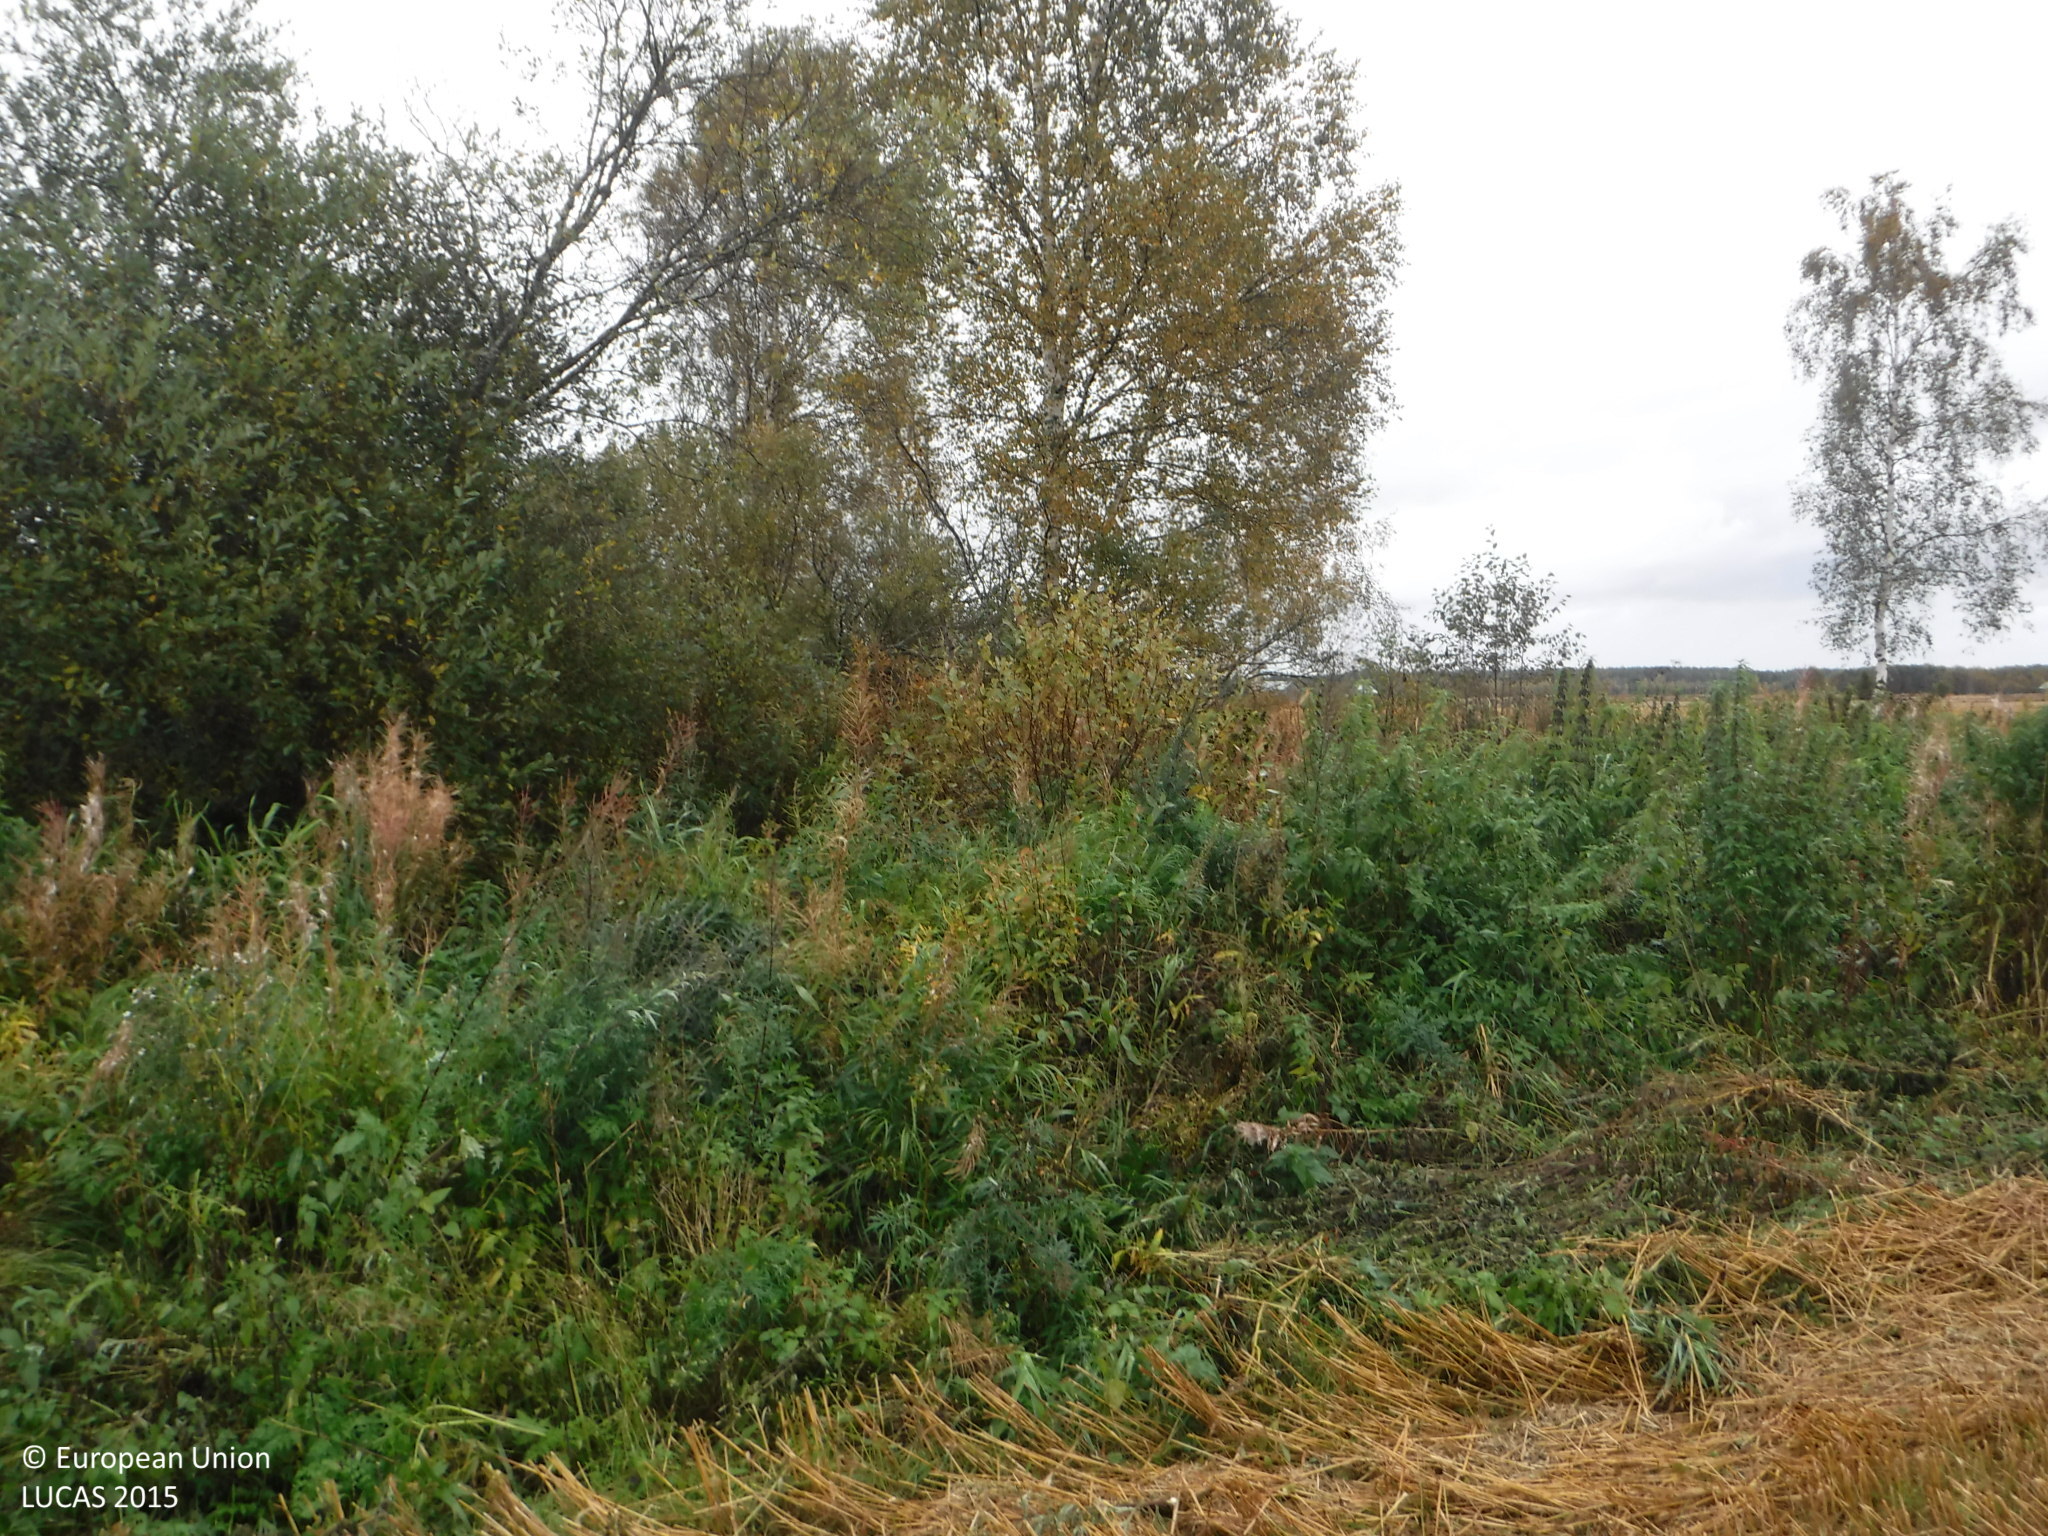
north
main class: Cropland
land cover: Oats
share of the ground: > 75 %
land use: Agriculture (excluding fallow land and kitchen gardens)
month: September
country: FI
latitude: 62.0289
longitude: 22.3463
